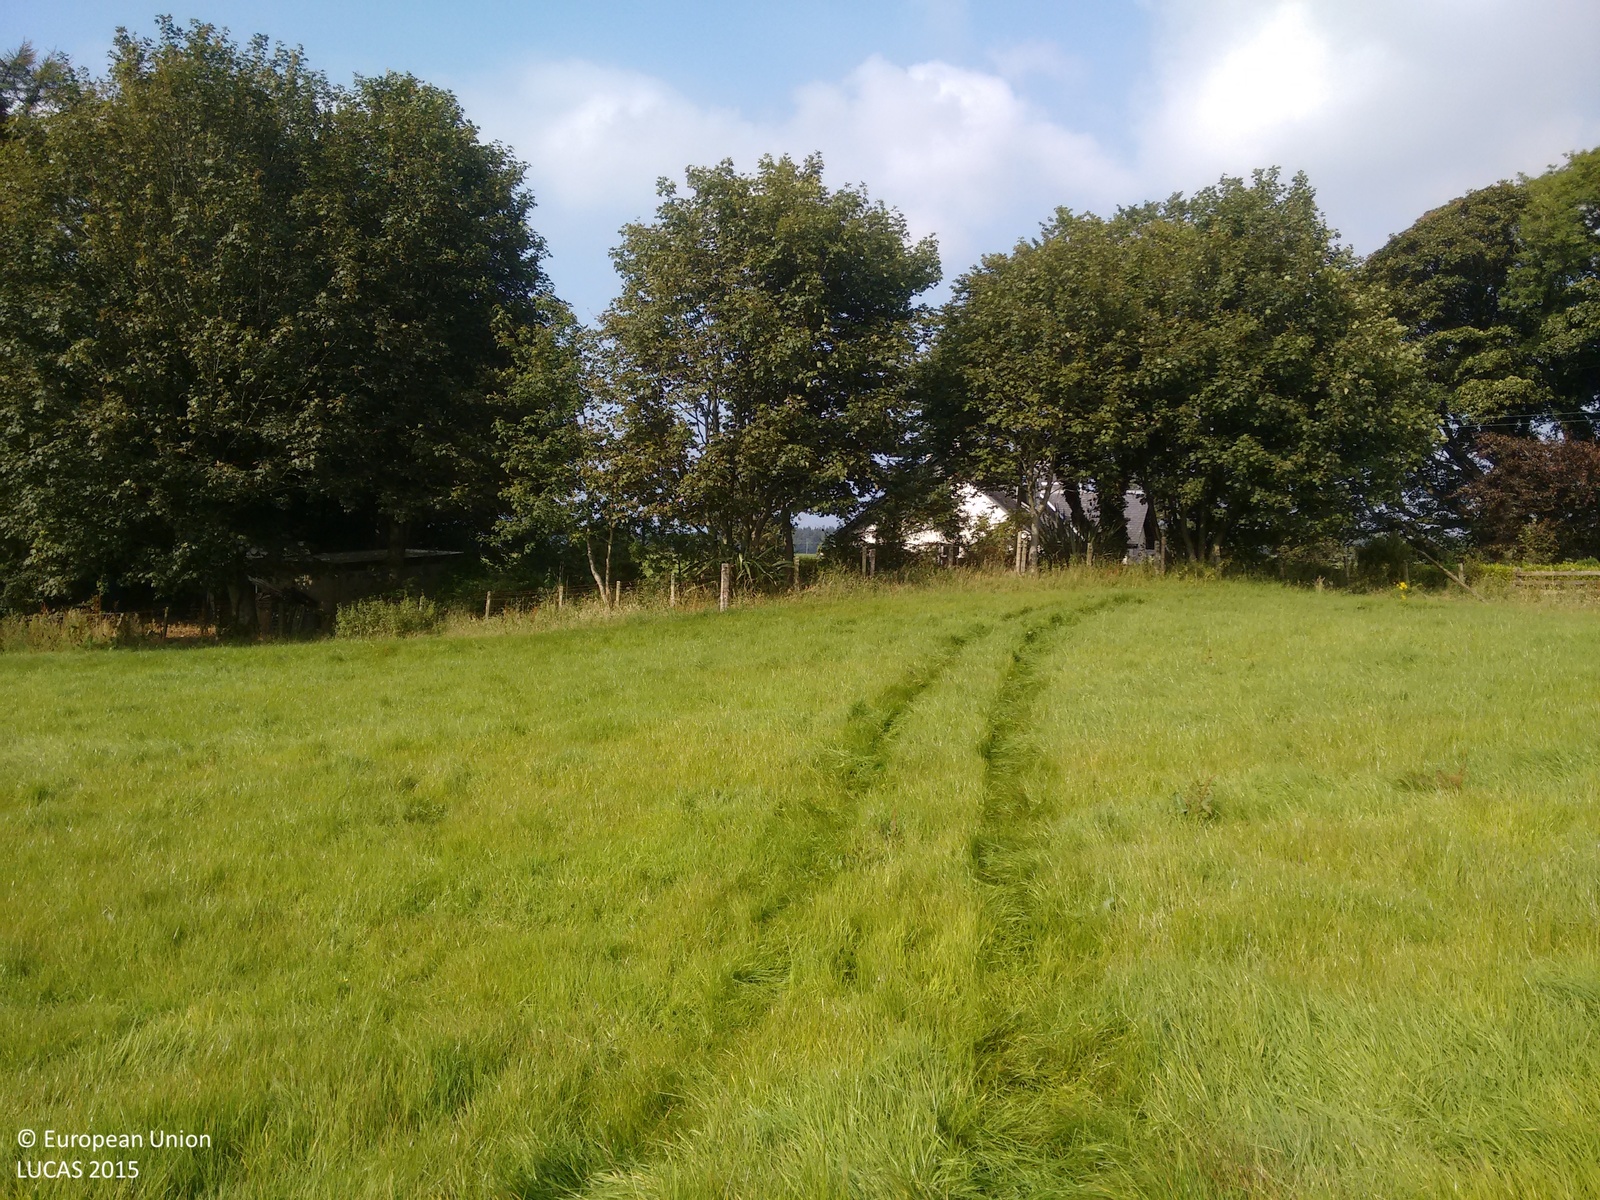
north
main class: Grassland
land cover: Grassland without tree/shrub cover
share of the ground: > 75 %
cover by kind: herbaceous plants 100 %
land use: Agriculture (excluding fallow land and kitchen gardens)
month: September
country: GB
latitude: 55.0814
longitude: -4.9786
